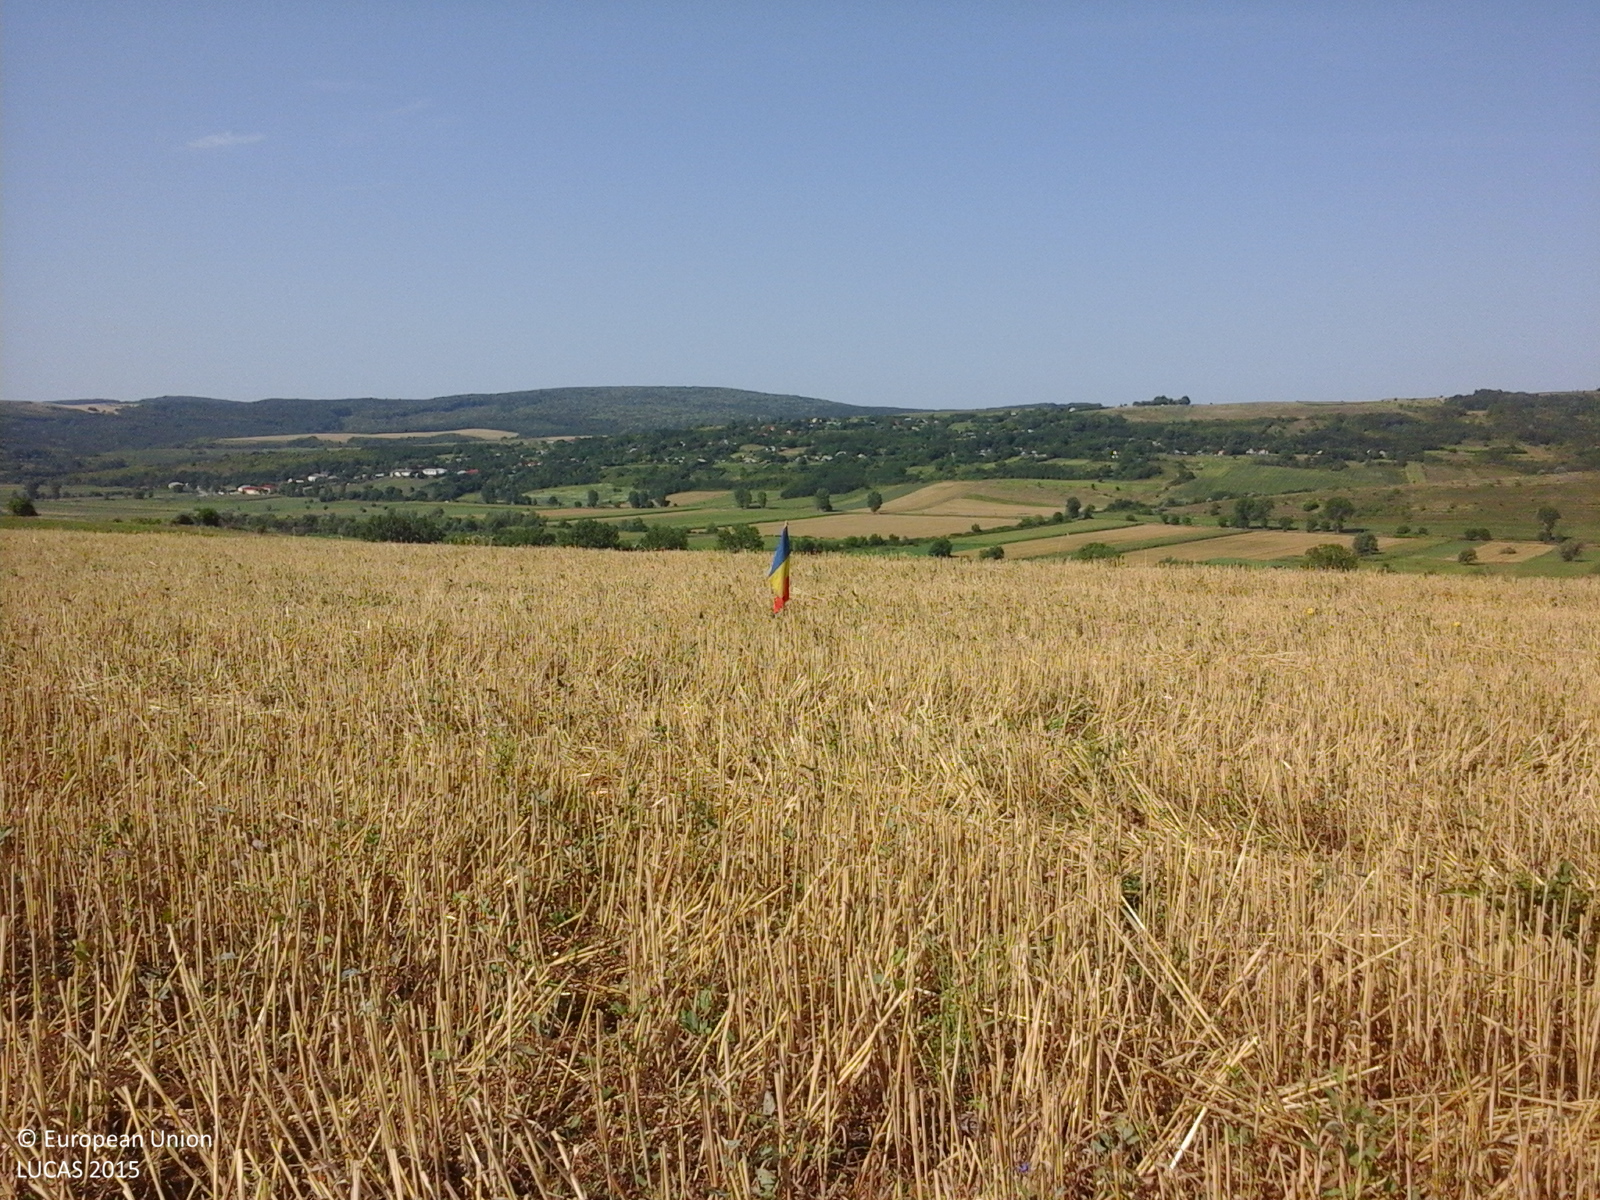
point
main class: Cropland
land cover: Common wheat
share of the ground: > 75 %
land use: Agriculture (excluding fallow land and kitchen gardens)
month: July
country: RO
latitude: 46.1762
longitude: 27.3180
